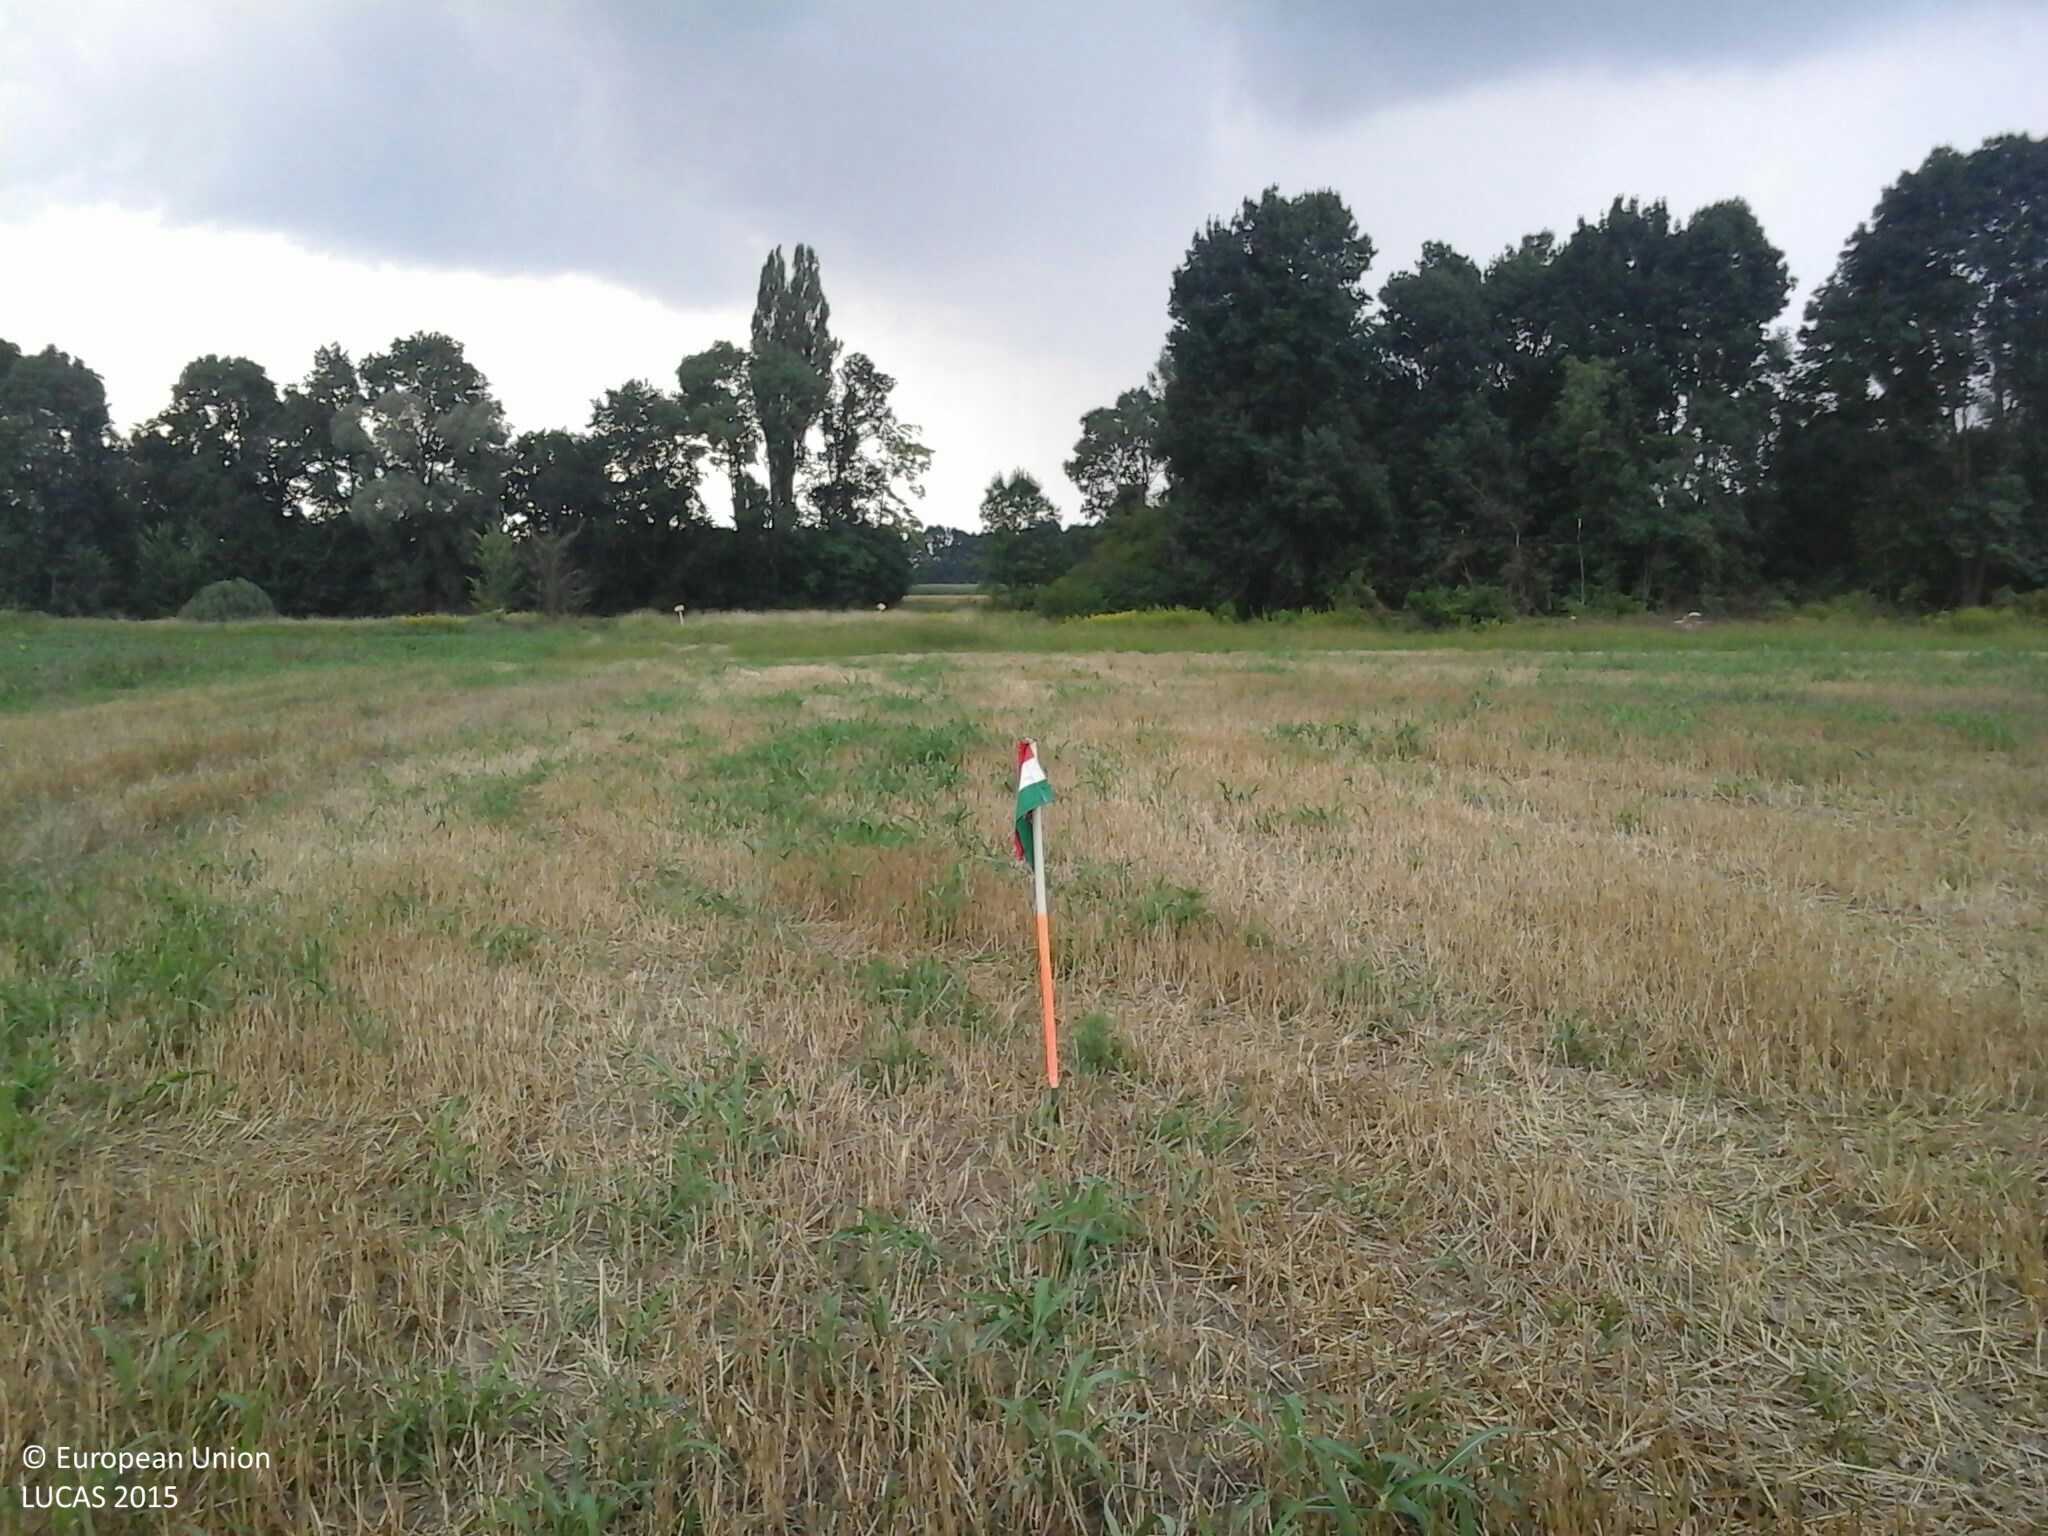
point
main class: Cropland
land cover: Common wheat
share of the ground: 25 - 50 %
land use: Agriculture (excluding fallow land and kitchen gardens)
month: August
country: HU
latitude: 45.8064
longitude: 18.1250
